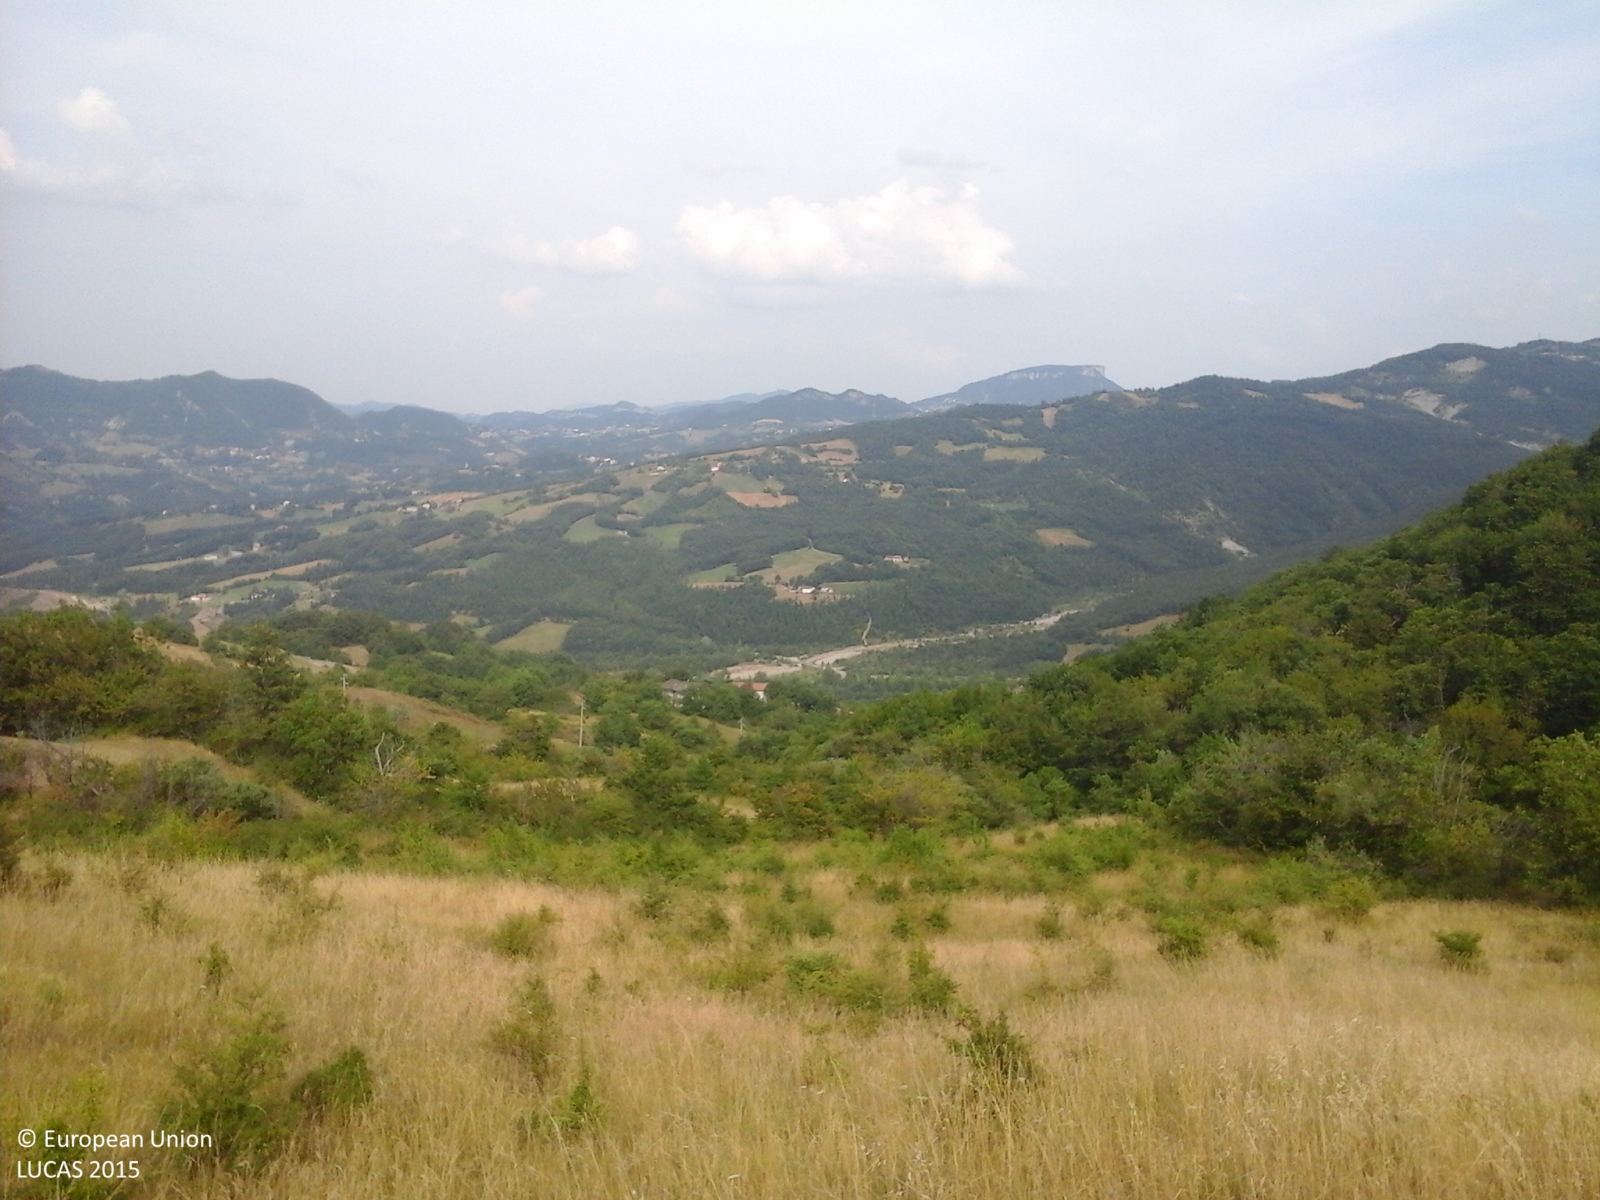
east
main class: Grassland
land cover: Grassland with sparse tree/shrub cover
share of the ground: > 75 %
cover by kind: herbaceous plants 90 %, broadleaved forest trees 5 %, shrubs 5 %
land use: Agriculture (excluding fallow land and kitchen gardens)
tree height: < 5 m
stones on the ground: 10 - 25 %
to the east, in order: Grassland with sparse tree/shrub cover; Managed hedges; Grassland without tree/shrub cover; Managed hedges; Grassland without tree/shrub cover
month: July
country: IT
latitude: 44.4403
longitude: 10.2883
